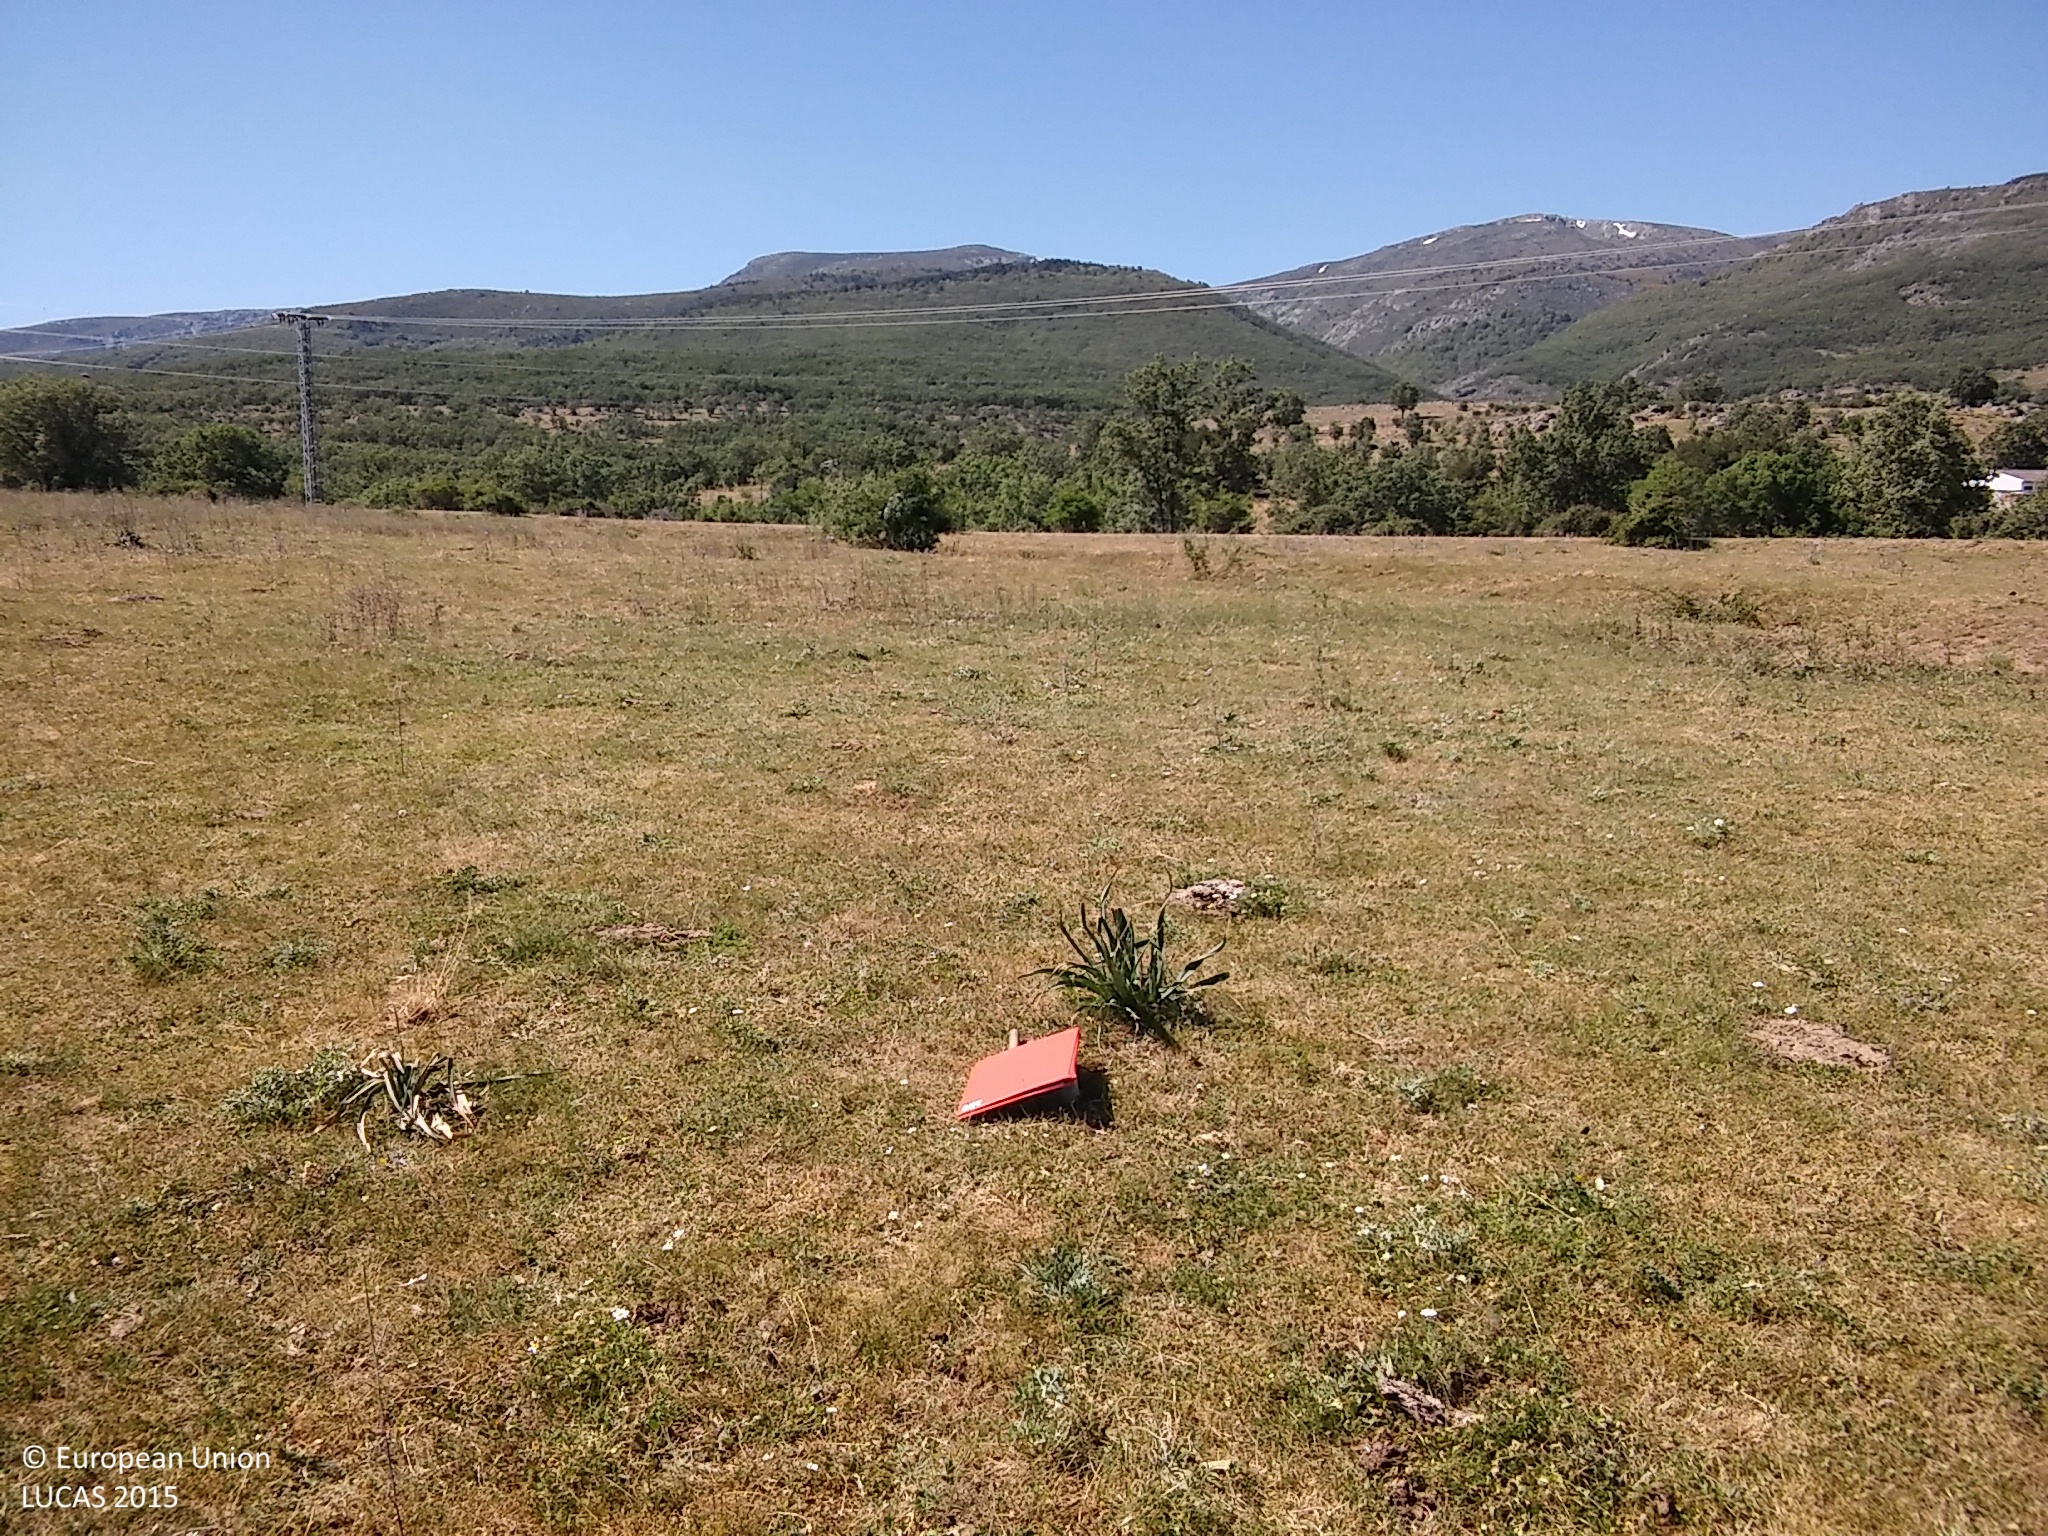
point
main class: Grassland
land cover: Grassland without tree/shrub cover
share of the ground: > 75 %
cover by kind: herbaceous plants 100 %
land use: Agriculture (excluding fallow land and kitchen gardens)
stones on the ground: < 10 %
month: May
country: ES
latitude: 40.9308
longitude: -3.8340
